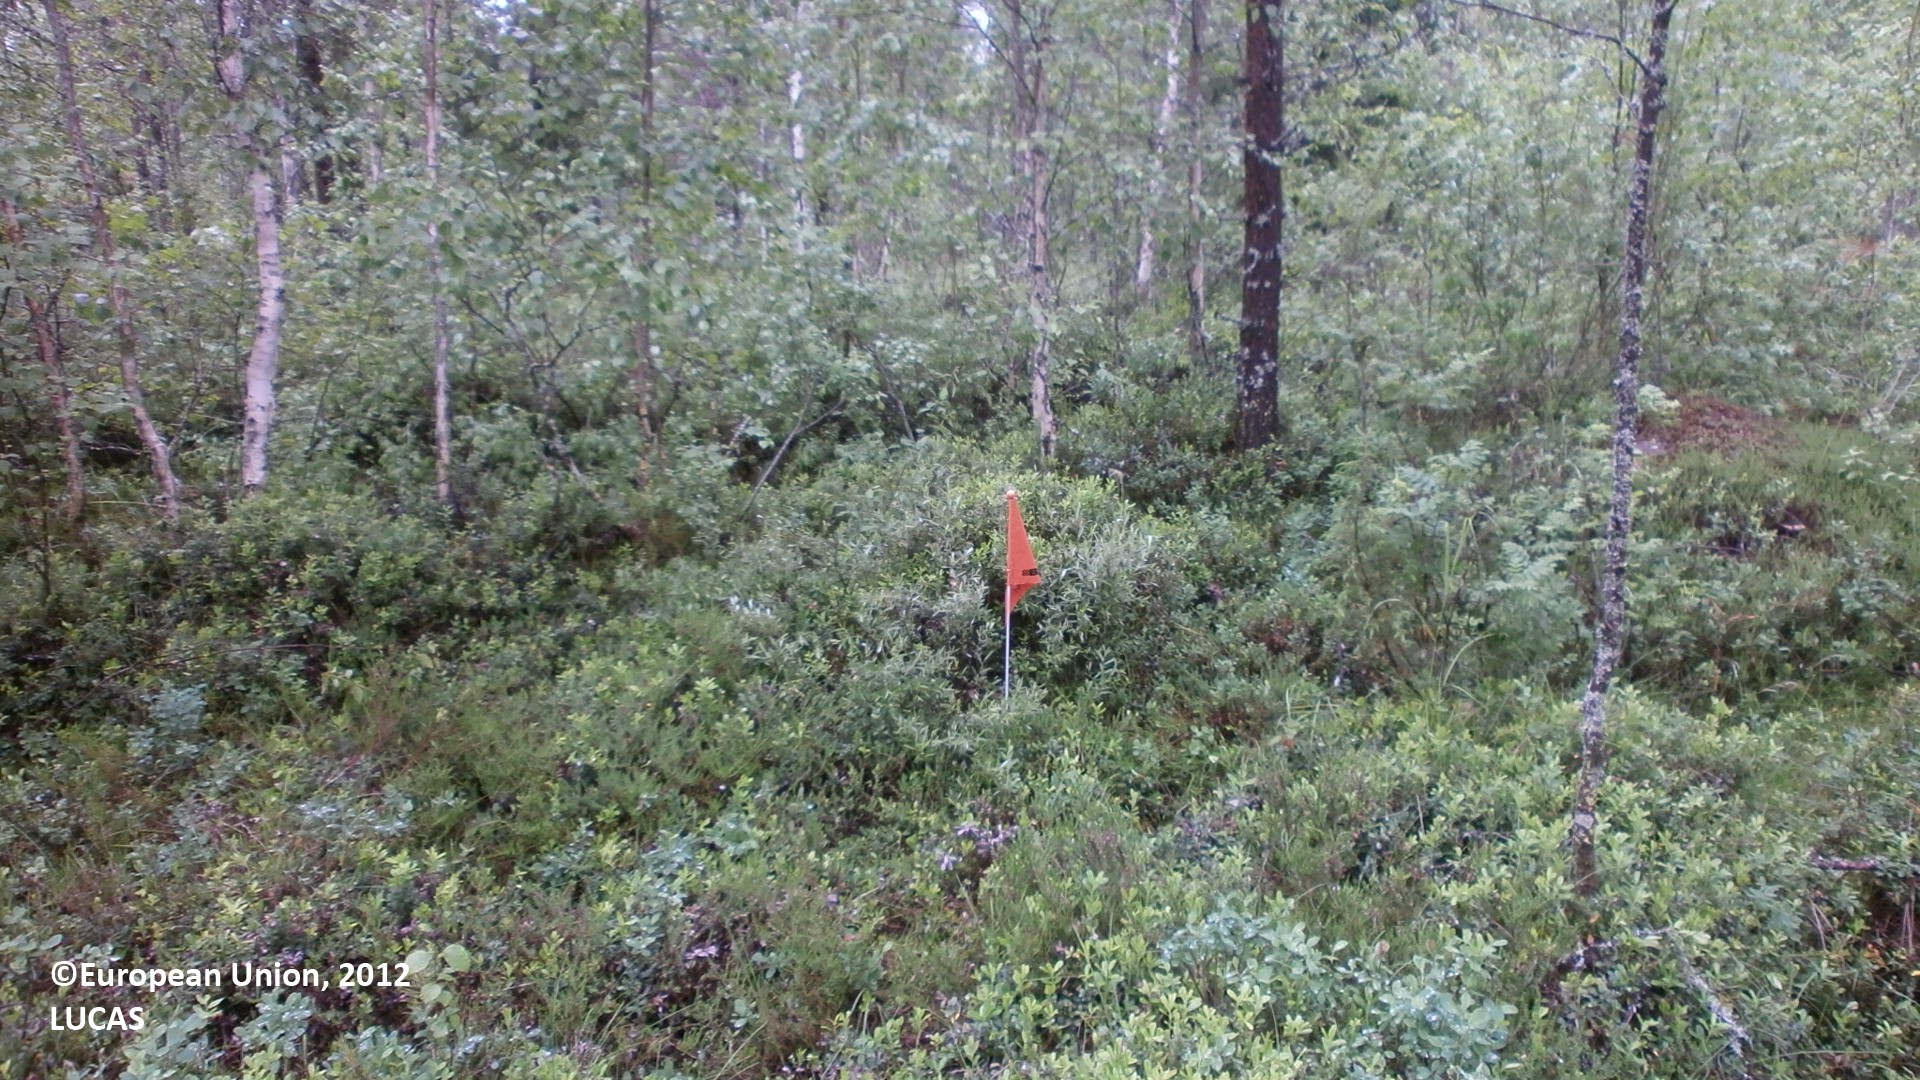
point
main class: Woodland
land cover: Pine dominated mixed woodland
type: boreal forest
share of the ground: 50 - 75 %
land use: Forestry
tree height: > 5 m
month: July
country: FI
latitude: 64.3862
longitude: 24.9443
